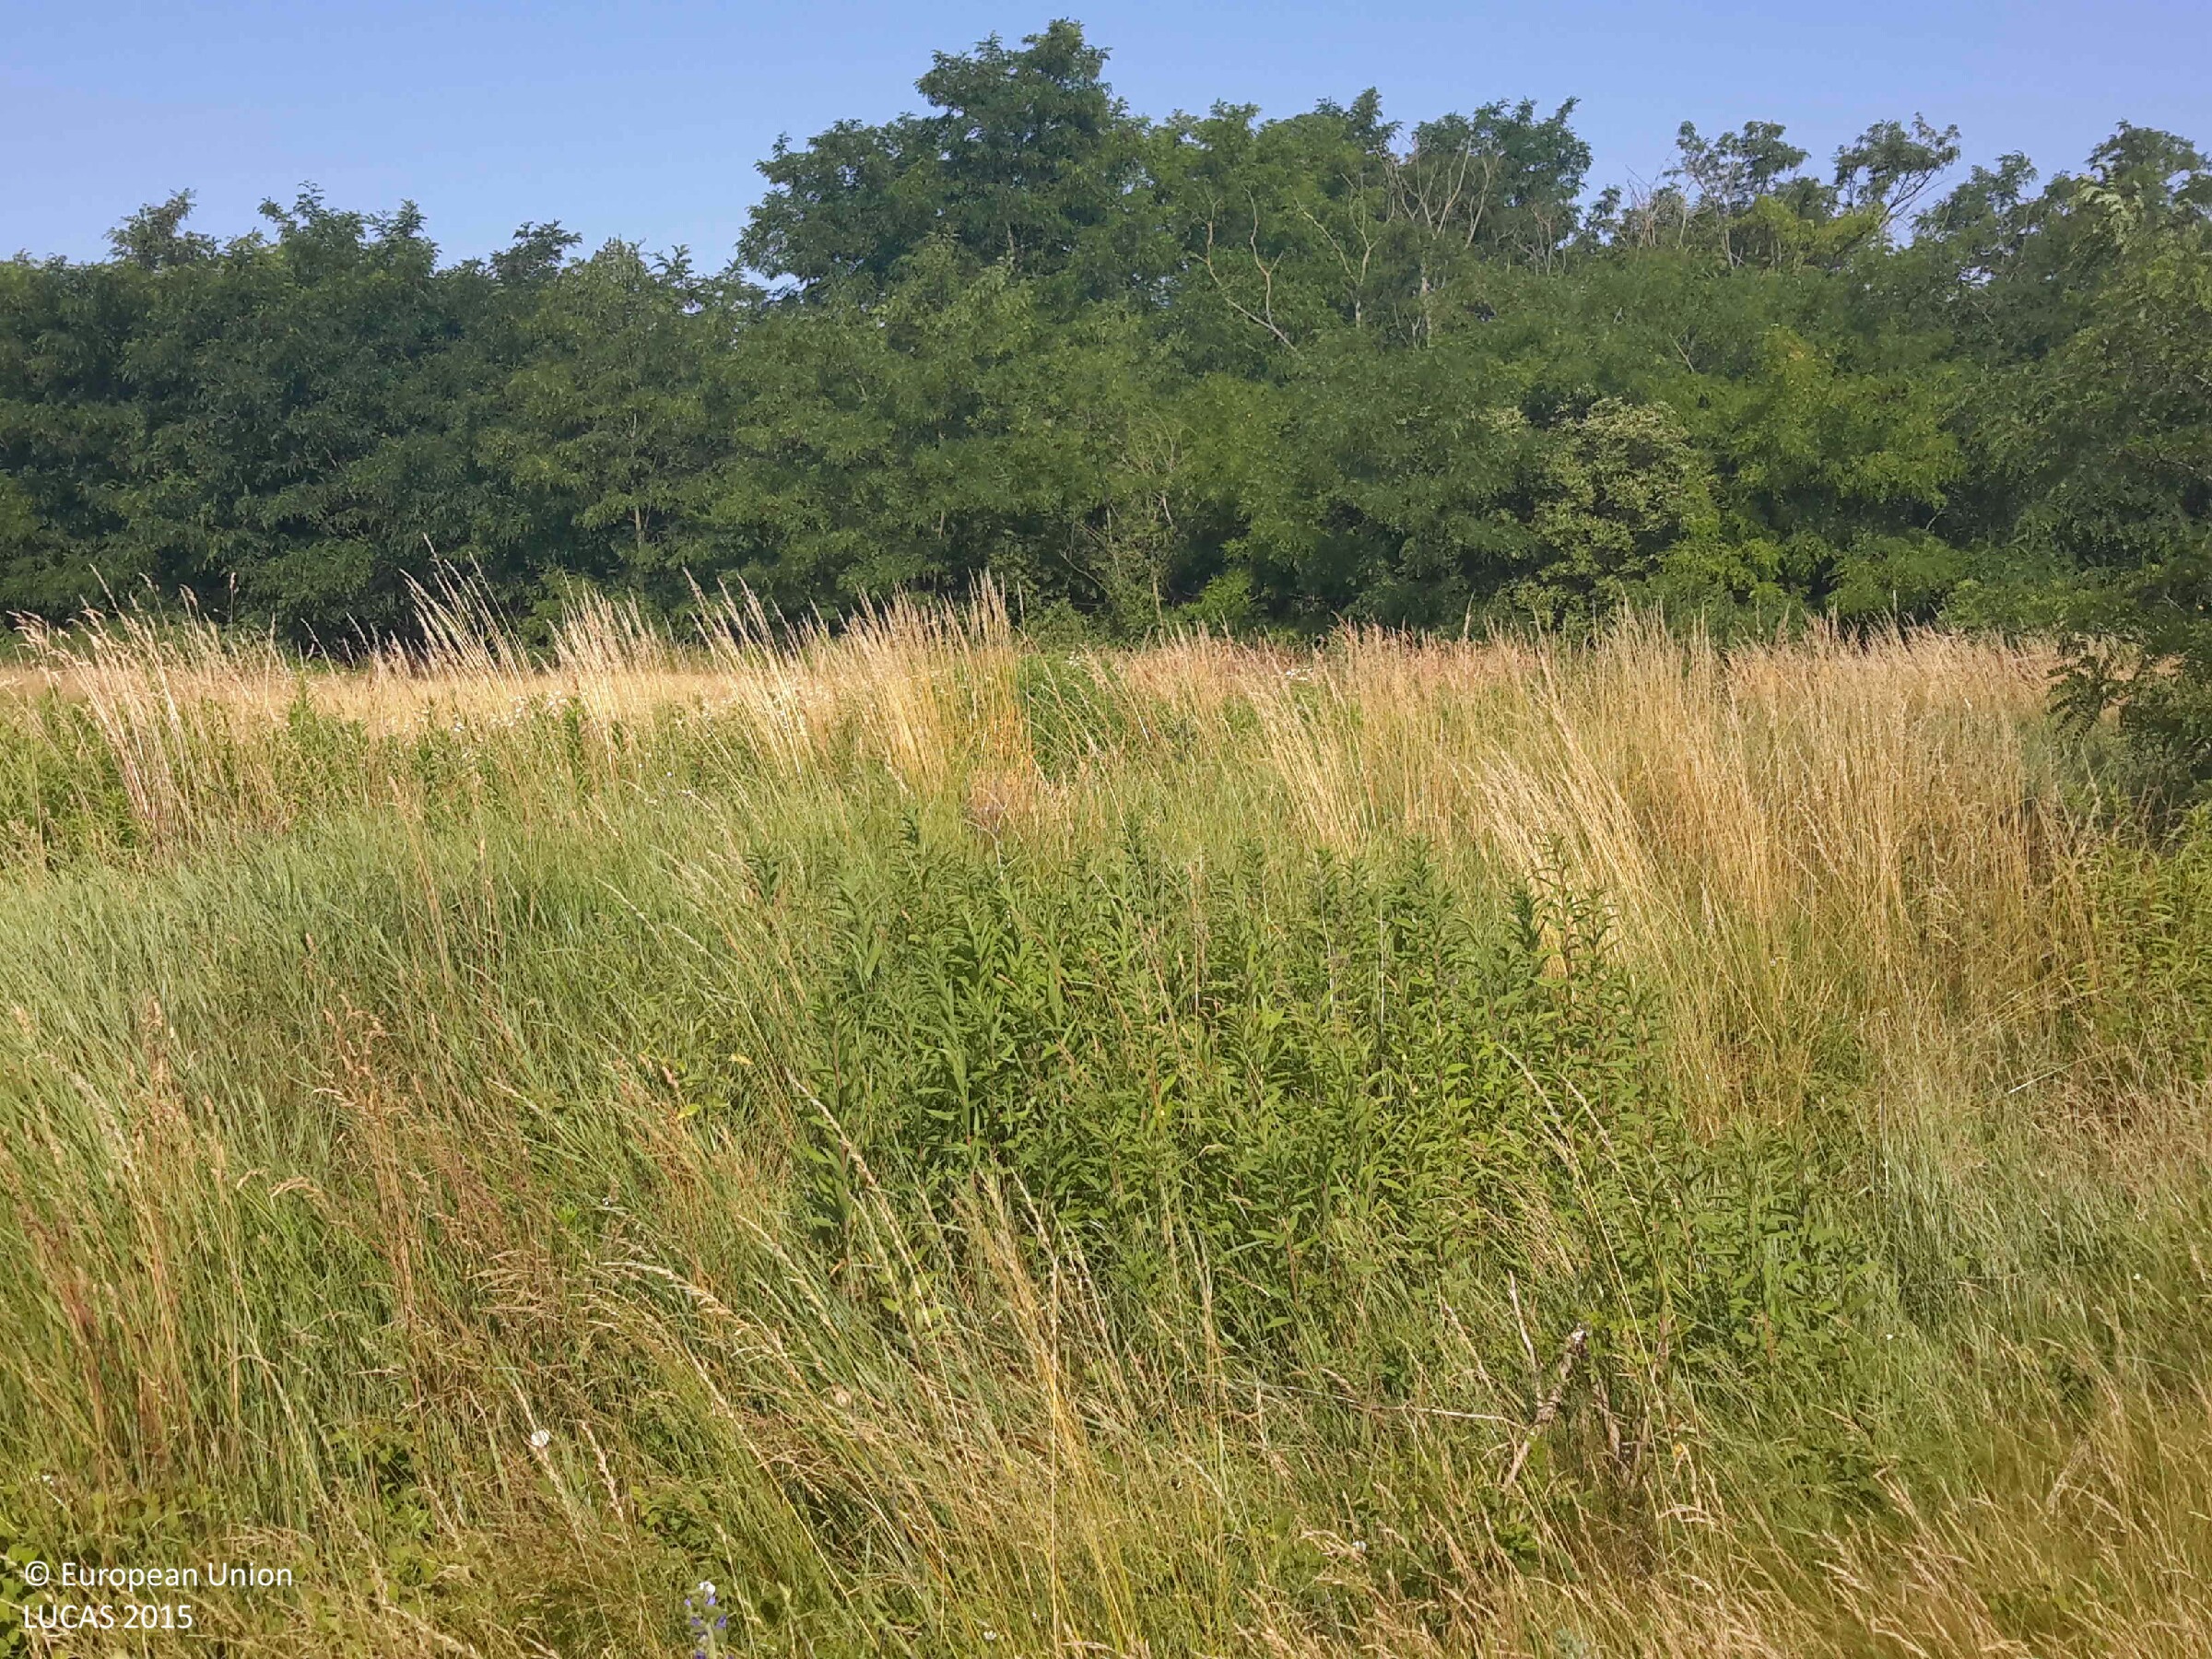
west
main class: Grassland
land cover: Spontaneously vegetated surfaces
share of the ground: > 75 %
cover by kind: herbaceous plants 100 %
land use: Abandoned areas
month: June
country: HU
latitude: 47.6693
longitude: 17.3727
